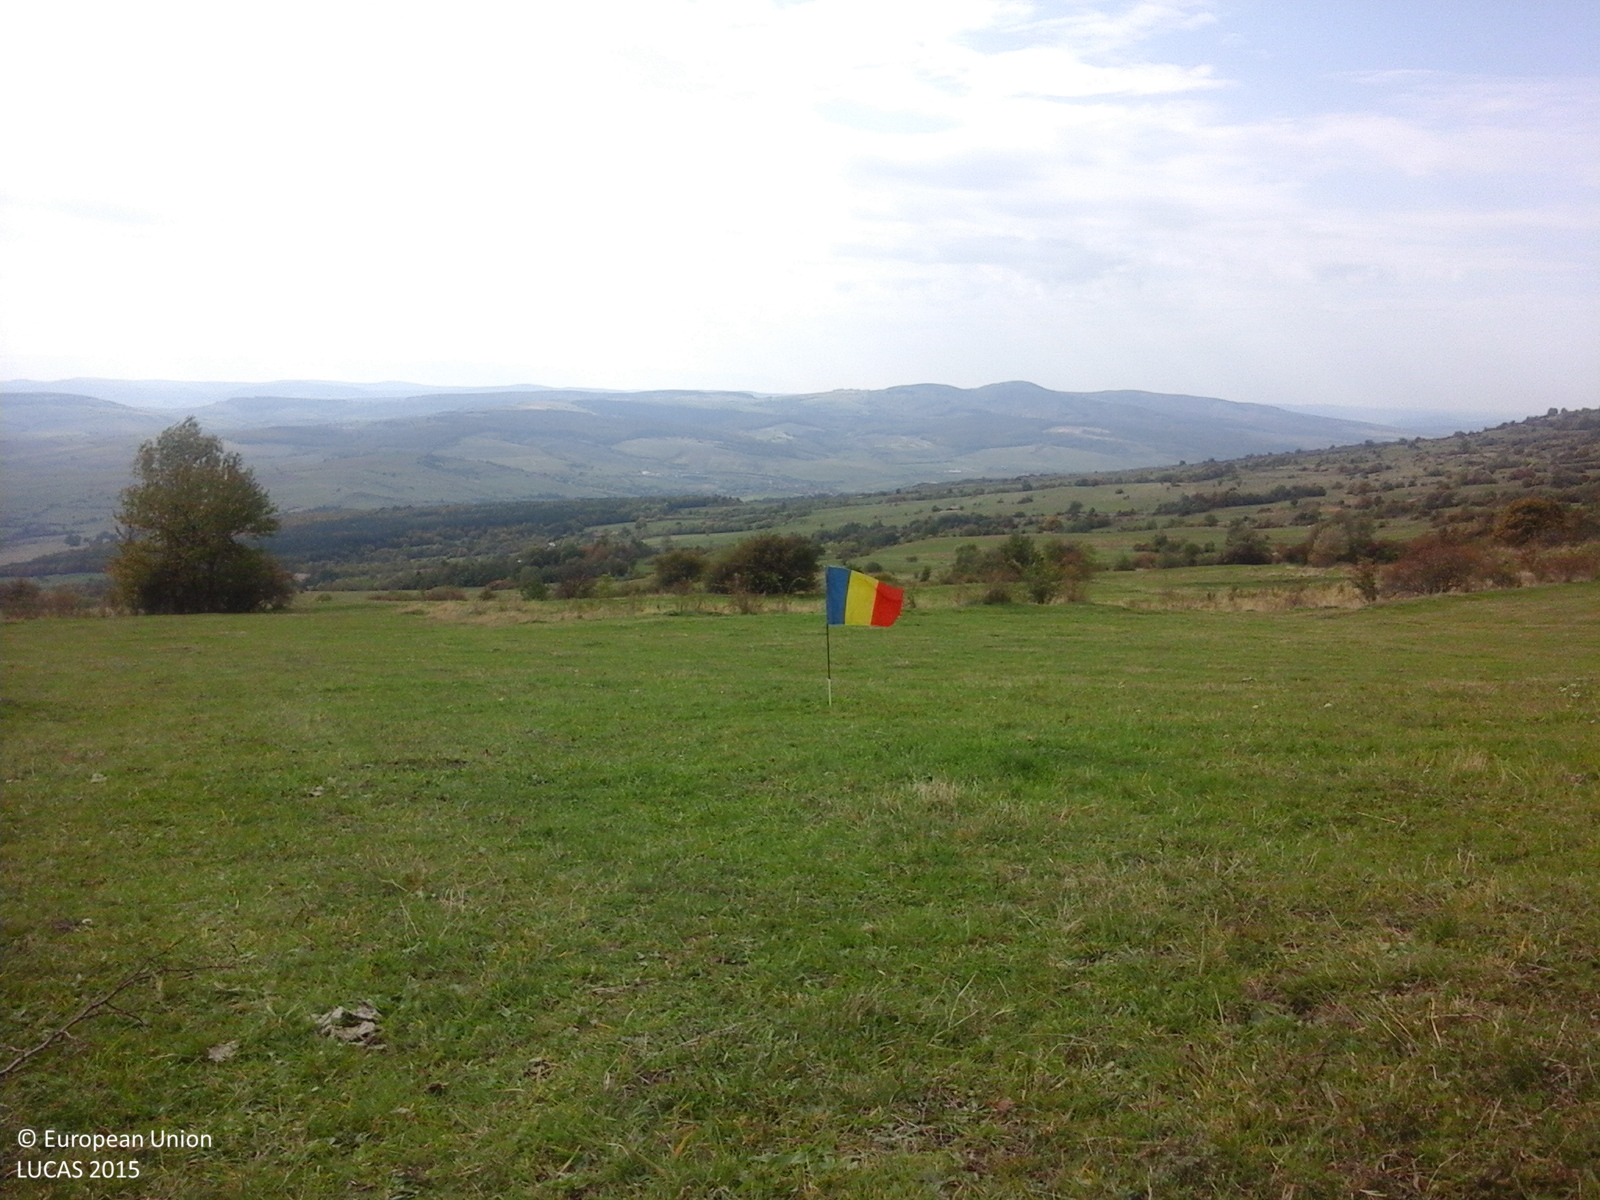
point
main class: Grassland
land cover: Grassland without tree/shrub cover
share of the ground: > 75 %
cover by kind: herbaceous plants 100 %
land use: Agriculture (excluding fallow land and kitchen gardens)
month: October
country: RO
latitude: 46.3991
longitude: 25.2813
